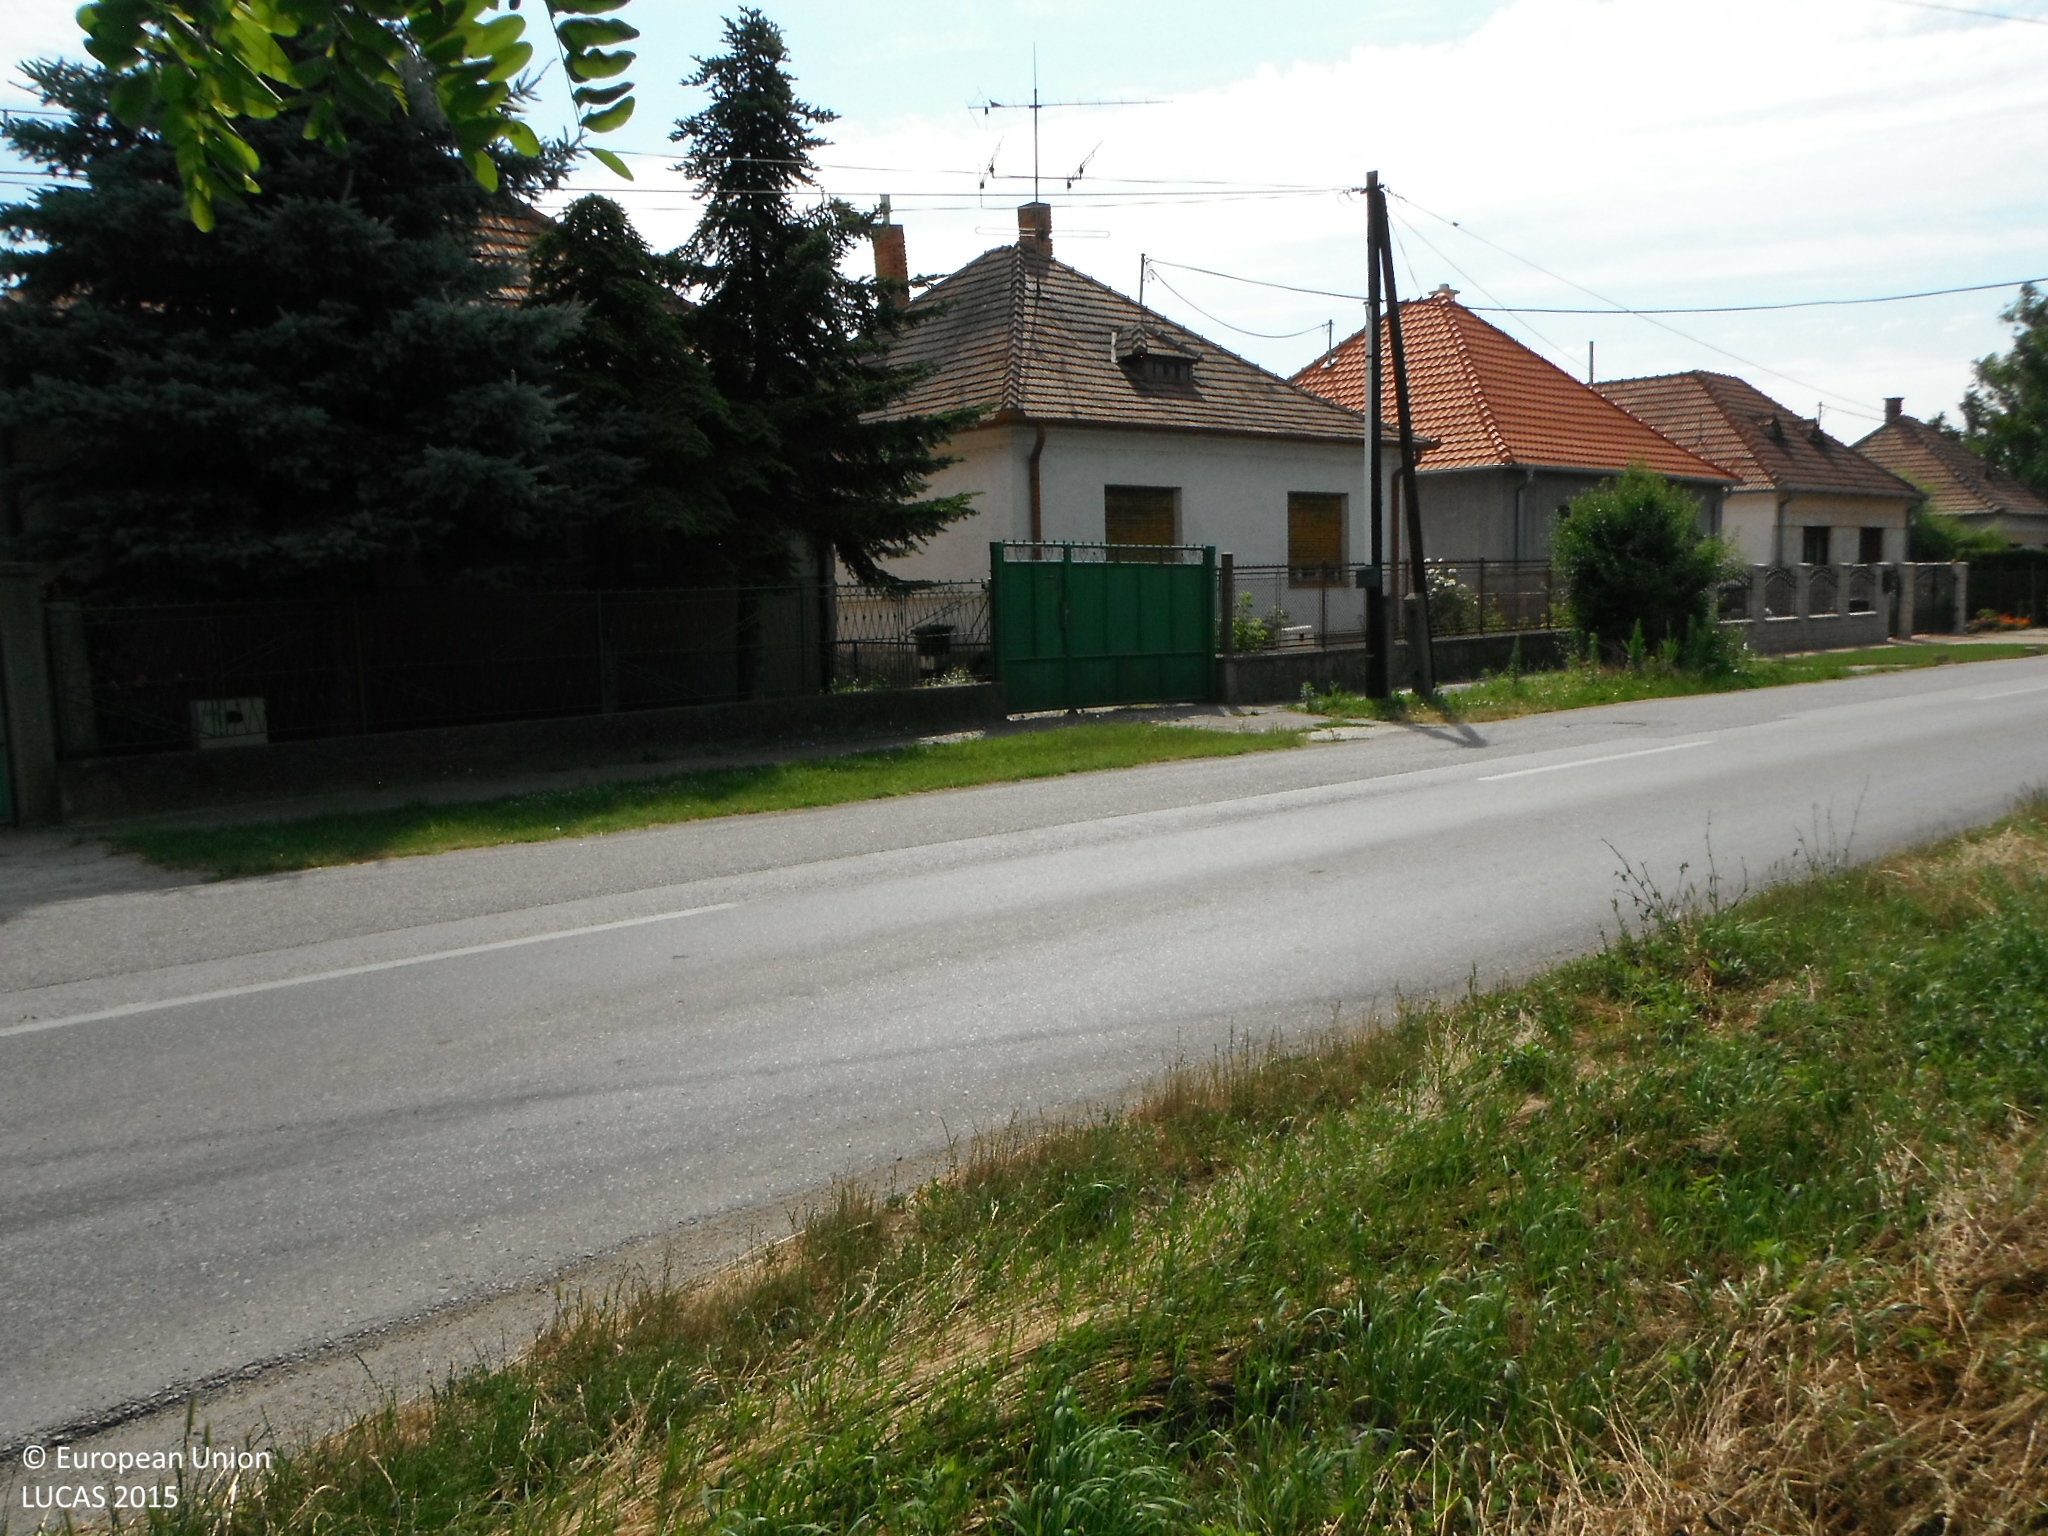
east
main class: Grassland
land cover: Grassland with sparse tree/shrub cover
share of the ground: > 75 %
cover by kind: herbaceous plants 80 %, shrubs 10 %, broadleaved forest trees 5 %, unconsolidated bare surface 5 %
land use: Semi-natural and natural areas not in use
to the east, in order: Grassland with sparse tree/shrub cover; Artificial constructions in urban areas; Shrubland with sparse tree cover; Tracks; Grassland without tree/shrub cover; Inland marshes; Inland fresh water bodies; Inland marshes; Grassland without tree/shrub cover; Artificial constructions in urban areas
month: June
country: SK
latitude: 48.2234
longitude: 17.7242
